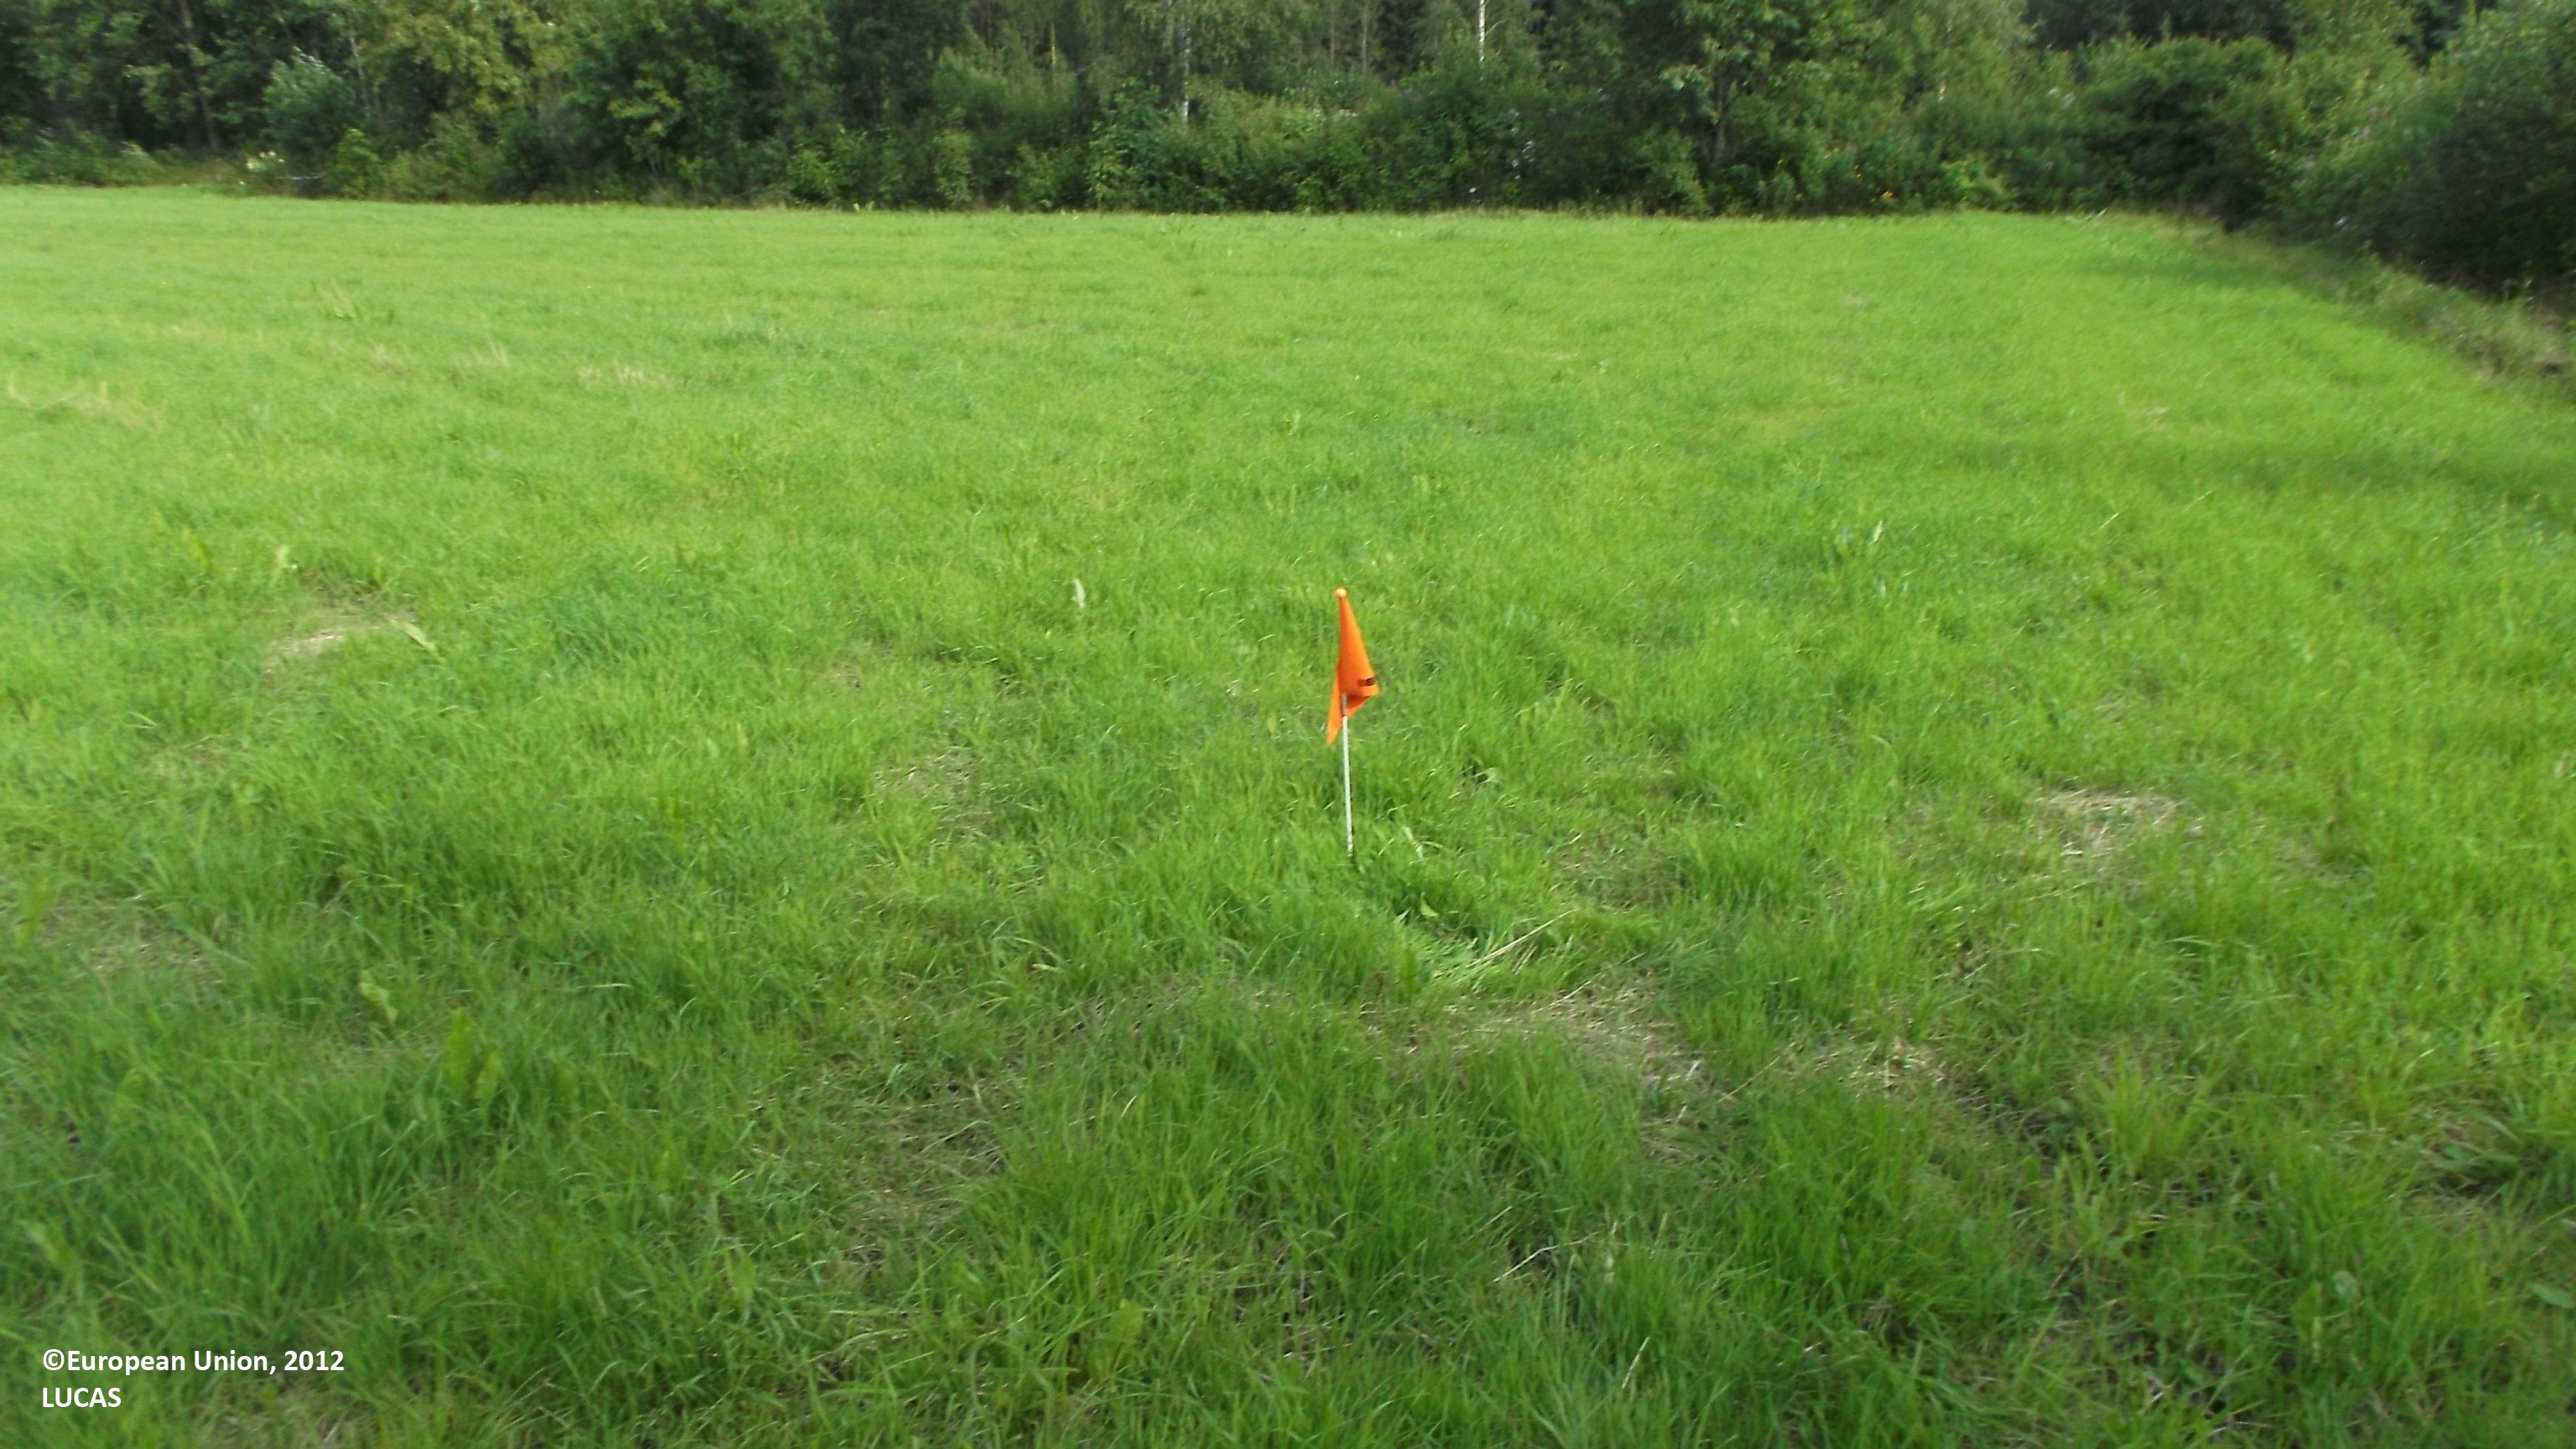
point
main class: Cropland
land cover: Temporary grasslands
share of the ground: > 75 %
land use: Agriculture (excluding fallow land and kitchen gardens)
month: July
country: FI
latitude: 63.7059
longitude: 23.3099
